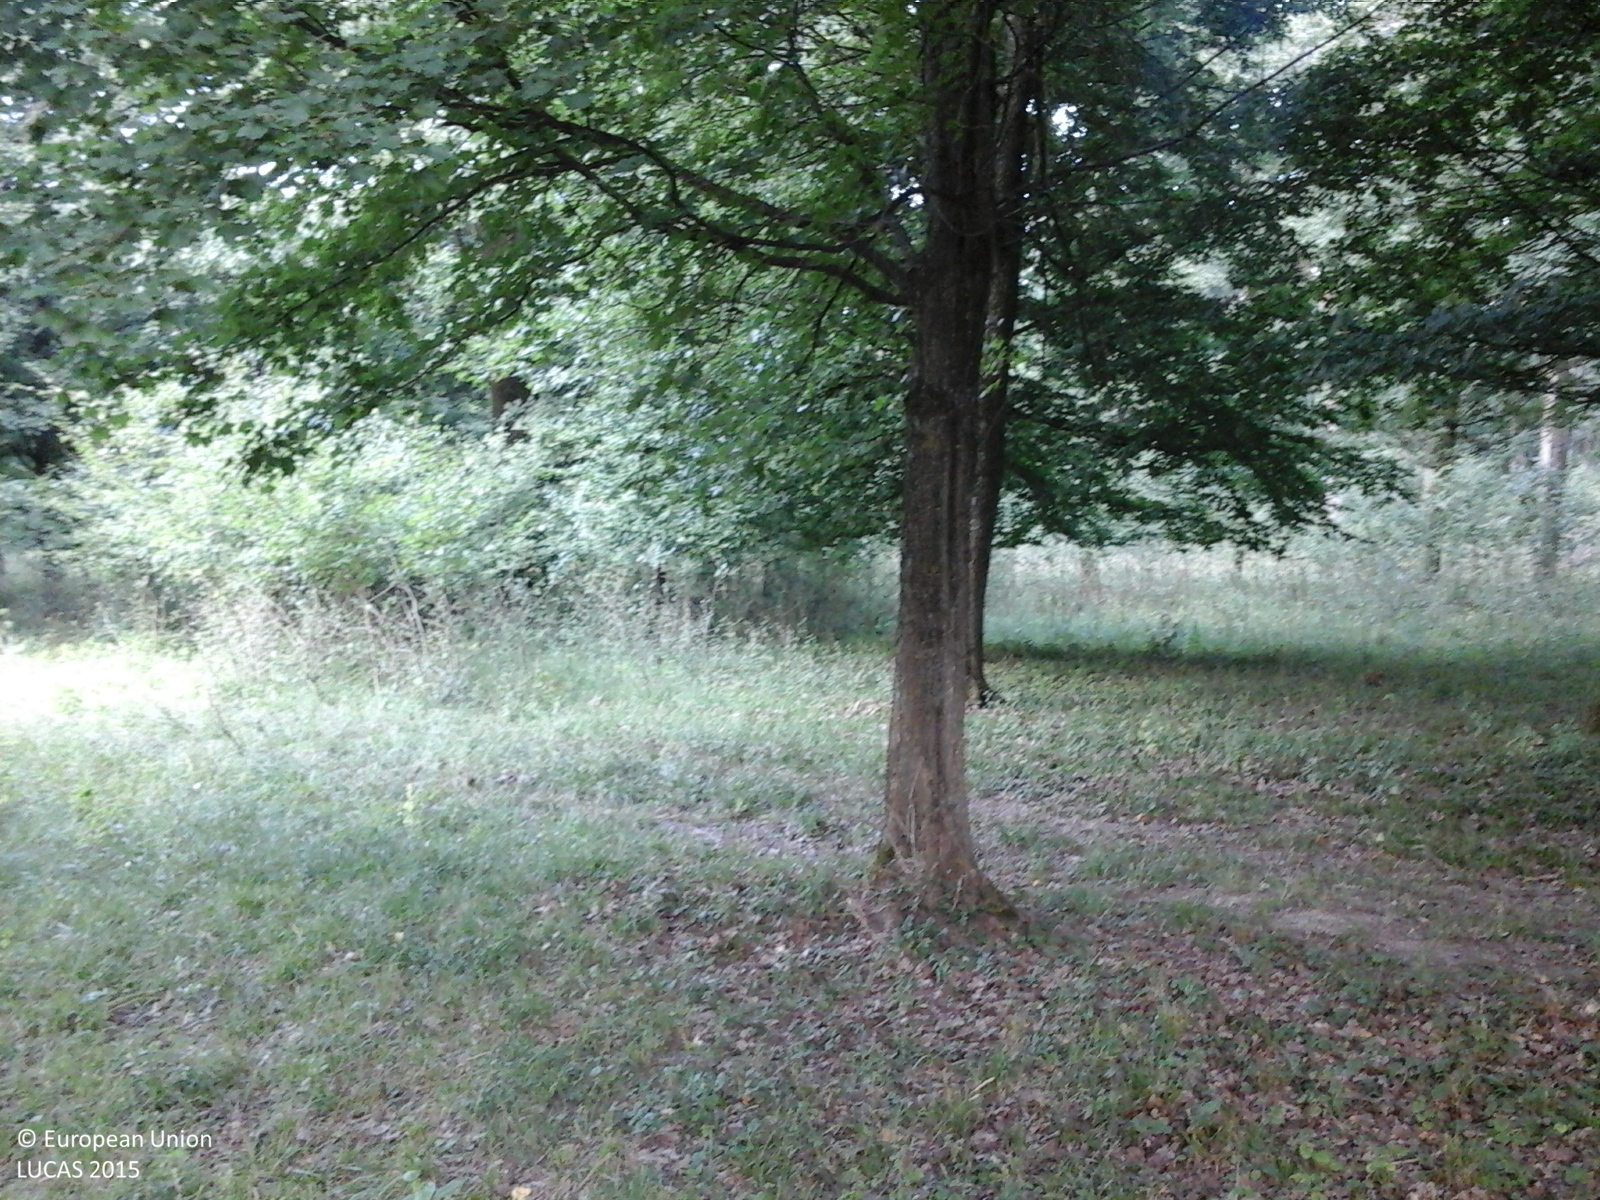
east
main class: Woodland
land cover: Broadleaved woodland
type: mesophytic deciduous forest
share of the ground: > 75 %
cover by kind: broadleaved forest trees 80 %, herbaceous plants 20 %
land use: Forestry
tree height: > 5 m
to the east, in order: Broadleaved woodland; Tracks; Broadleaved woodland
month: July
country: RO
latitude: 44.1835
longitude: 24.8998
